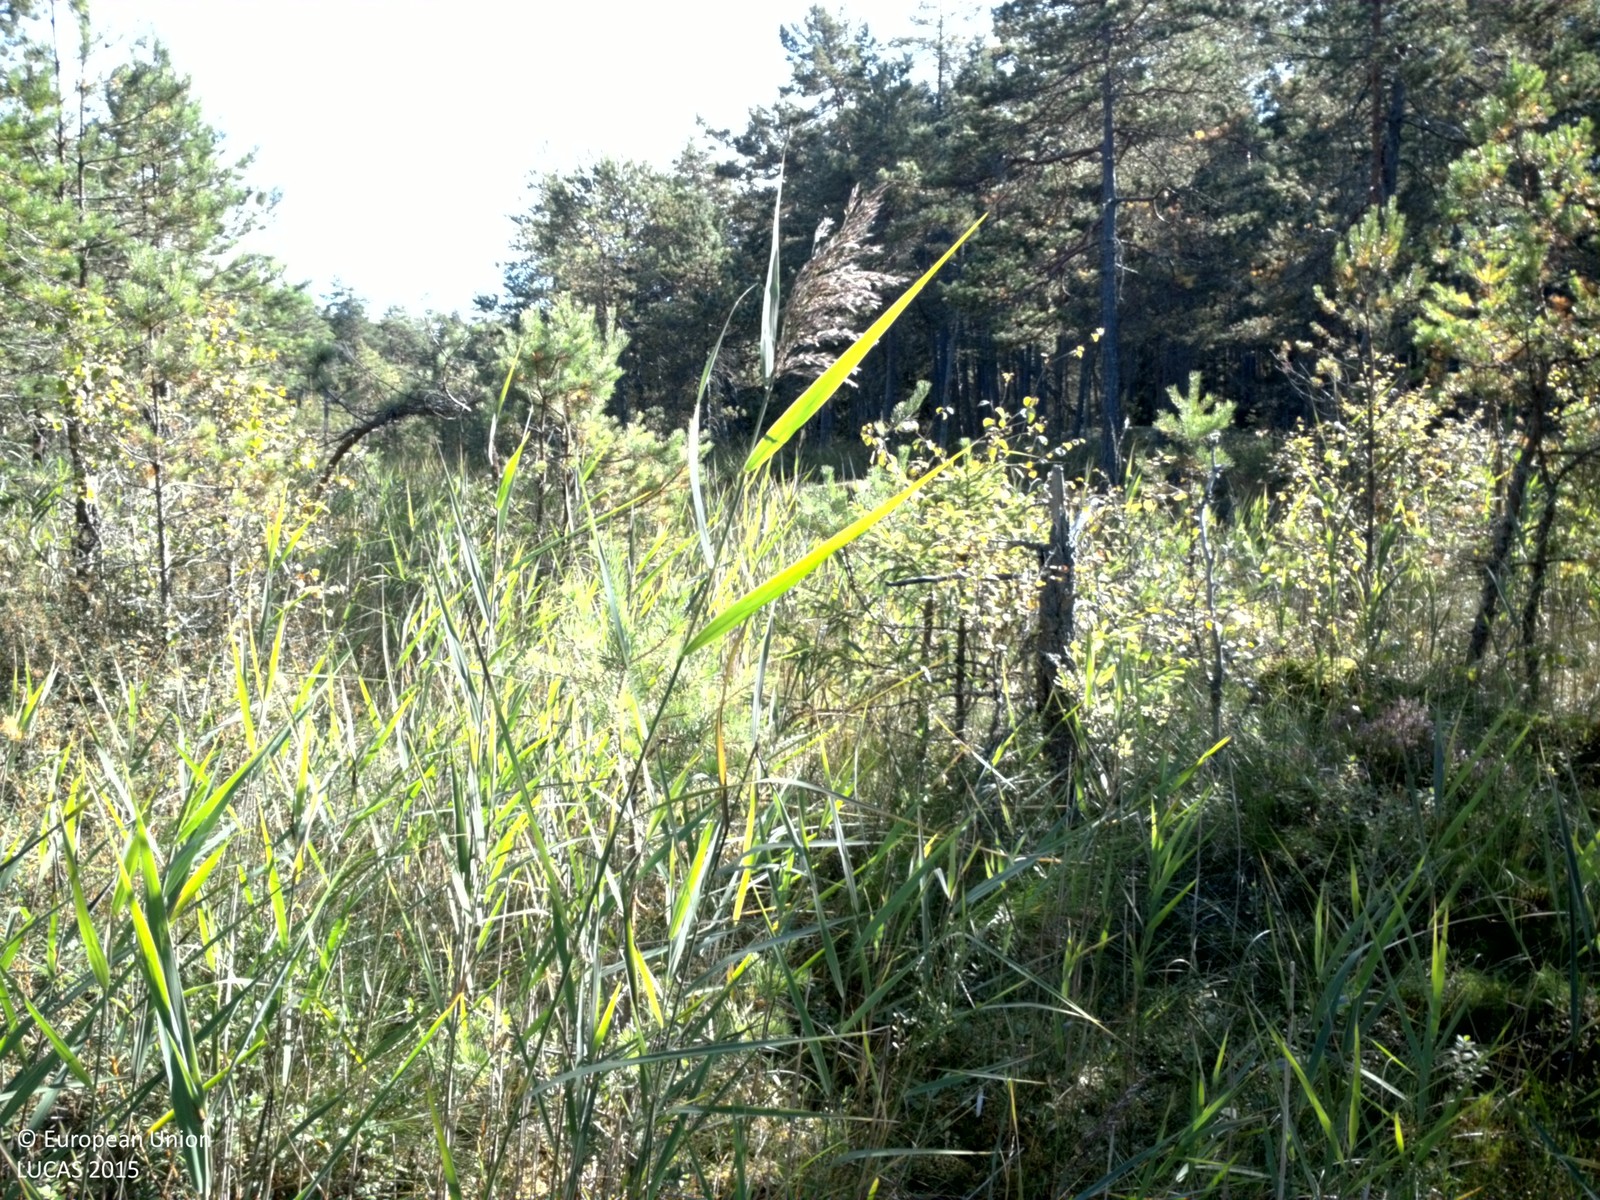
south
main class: Woodland
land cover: Pine dominated coniferous woodland
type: boreal forest
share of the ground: 25 - 50 %
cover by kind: lichens and mosses 55 %, coniferous forest trees 30 %, herbaceous plants 10 %, shrubs 5 %
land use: Forestry
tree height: < 5 m
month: August
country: SE
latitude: 59.7867
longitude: 17.7449
